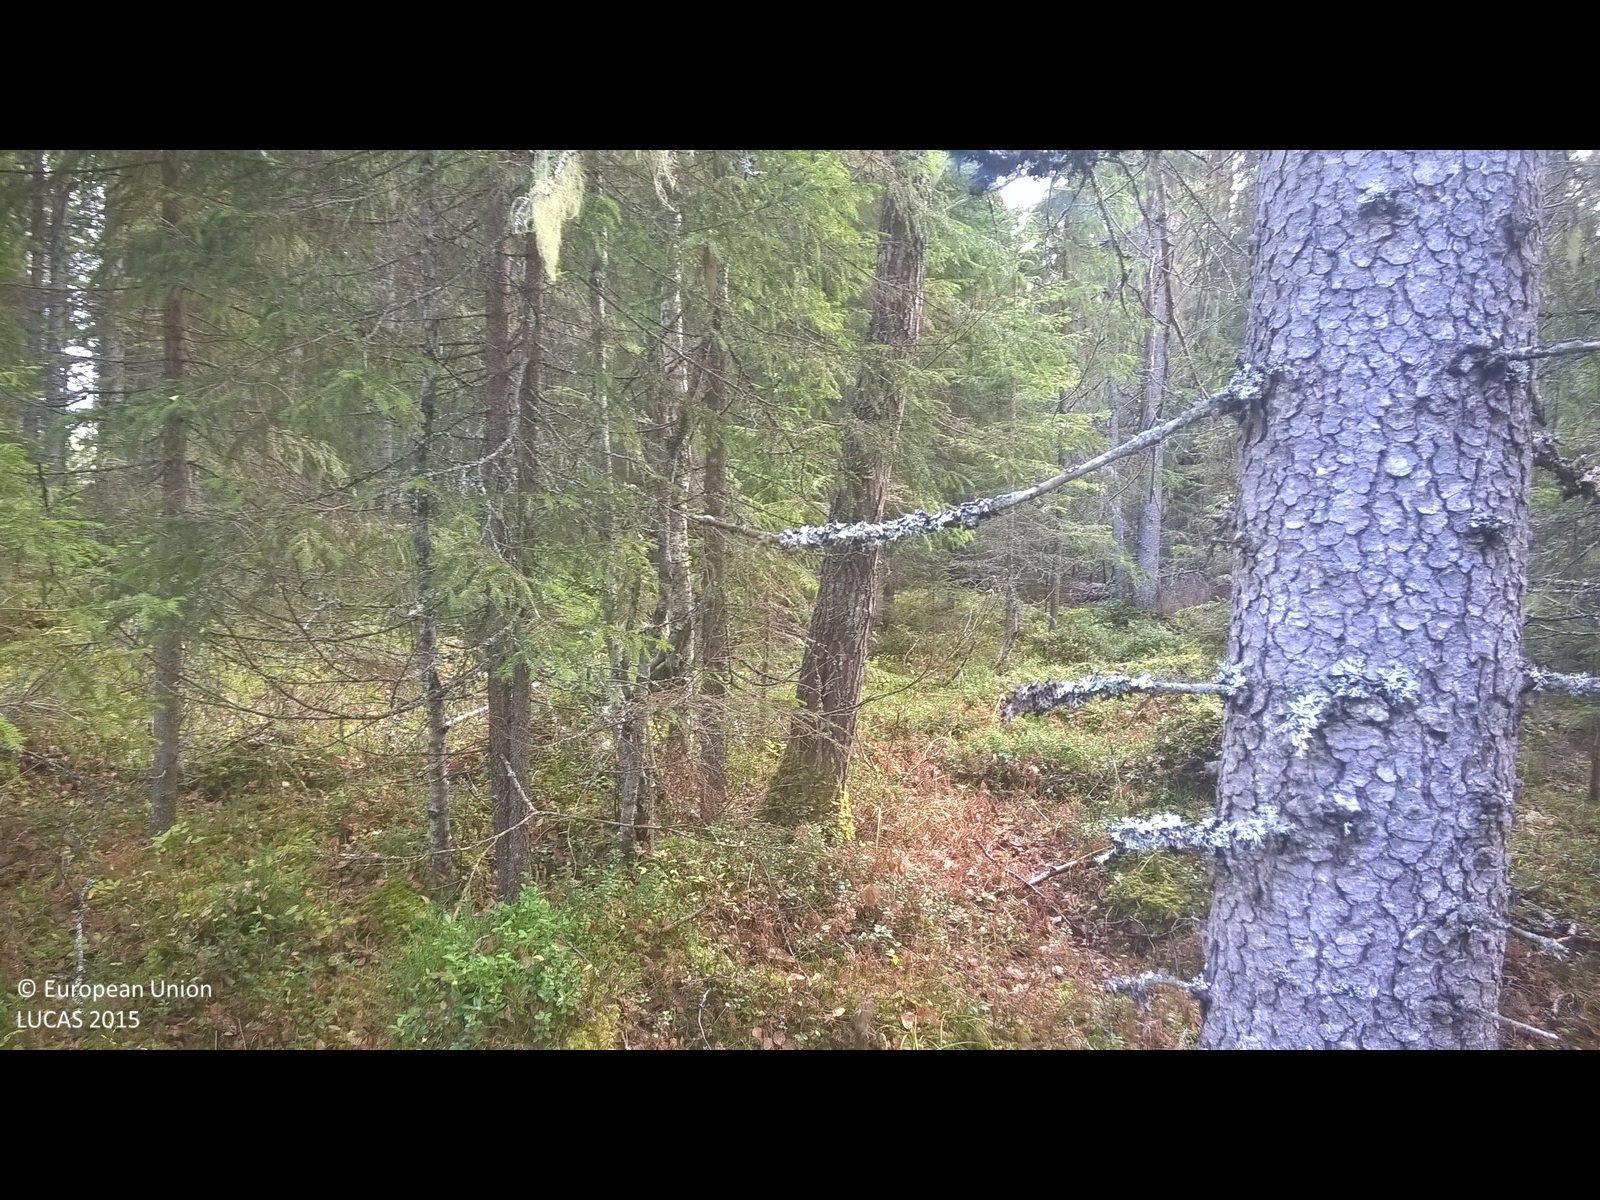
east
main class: Woodland
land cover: Spruce dominated coniferous woodland
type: boreal forest
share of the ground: 50 - 75 %
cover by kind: coniferous forest trees 60 %, lichens and mosses 30 %, broadleaved forest trees 10 %
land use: Forestry
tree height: > 5 m
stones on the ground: < 10 %
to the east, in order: Spruce dominated coniferous woodland; Ditches and canals; Grassland with sparse tree/shrub cover; Other mixed woodland; Ditches and canals; Grassland with sparse tree/shrub cover; Other mixed woodland
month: October
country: SE
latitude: 63.3388
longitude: 13.8759
